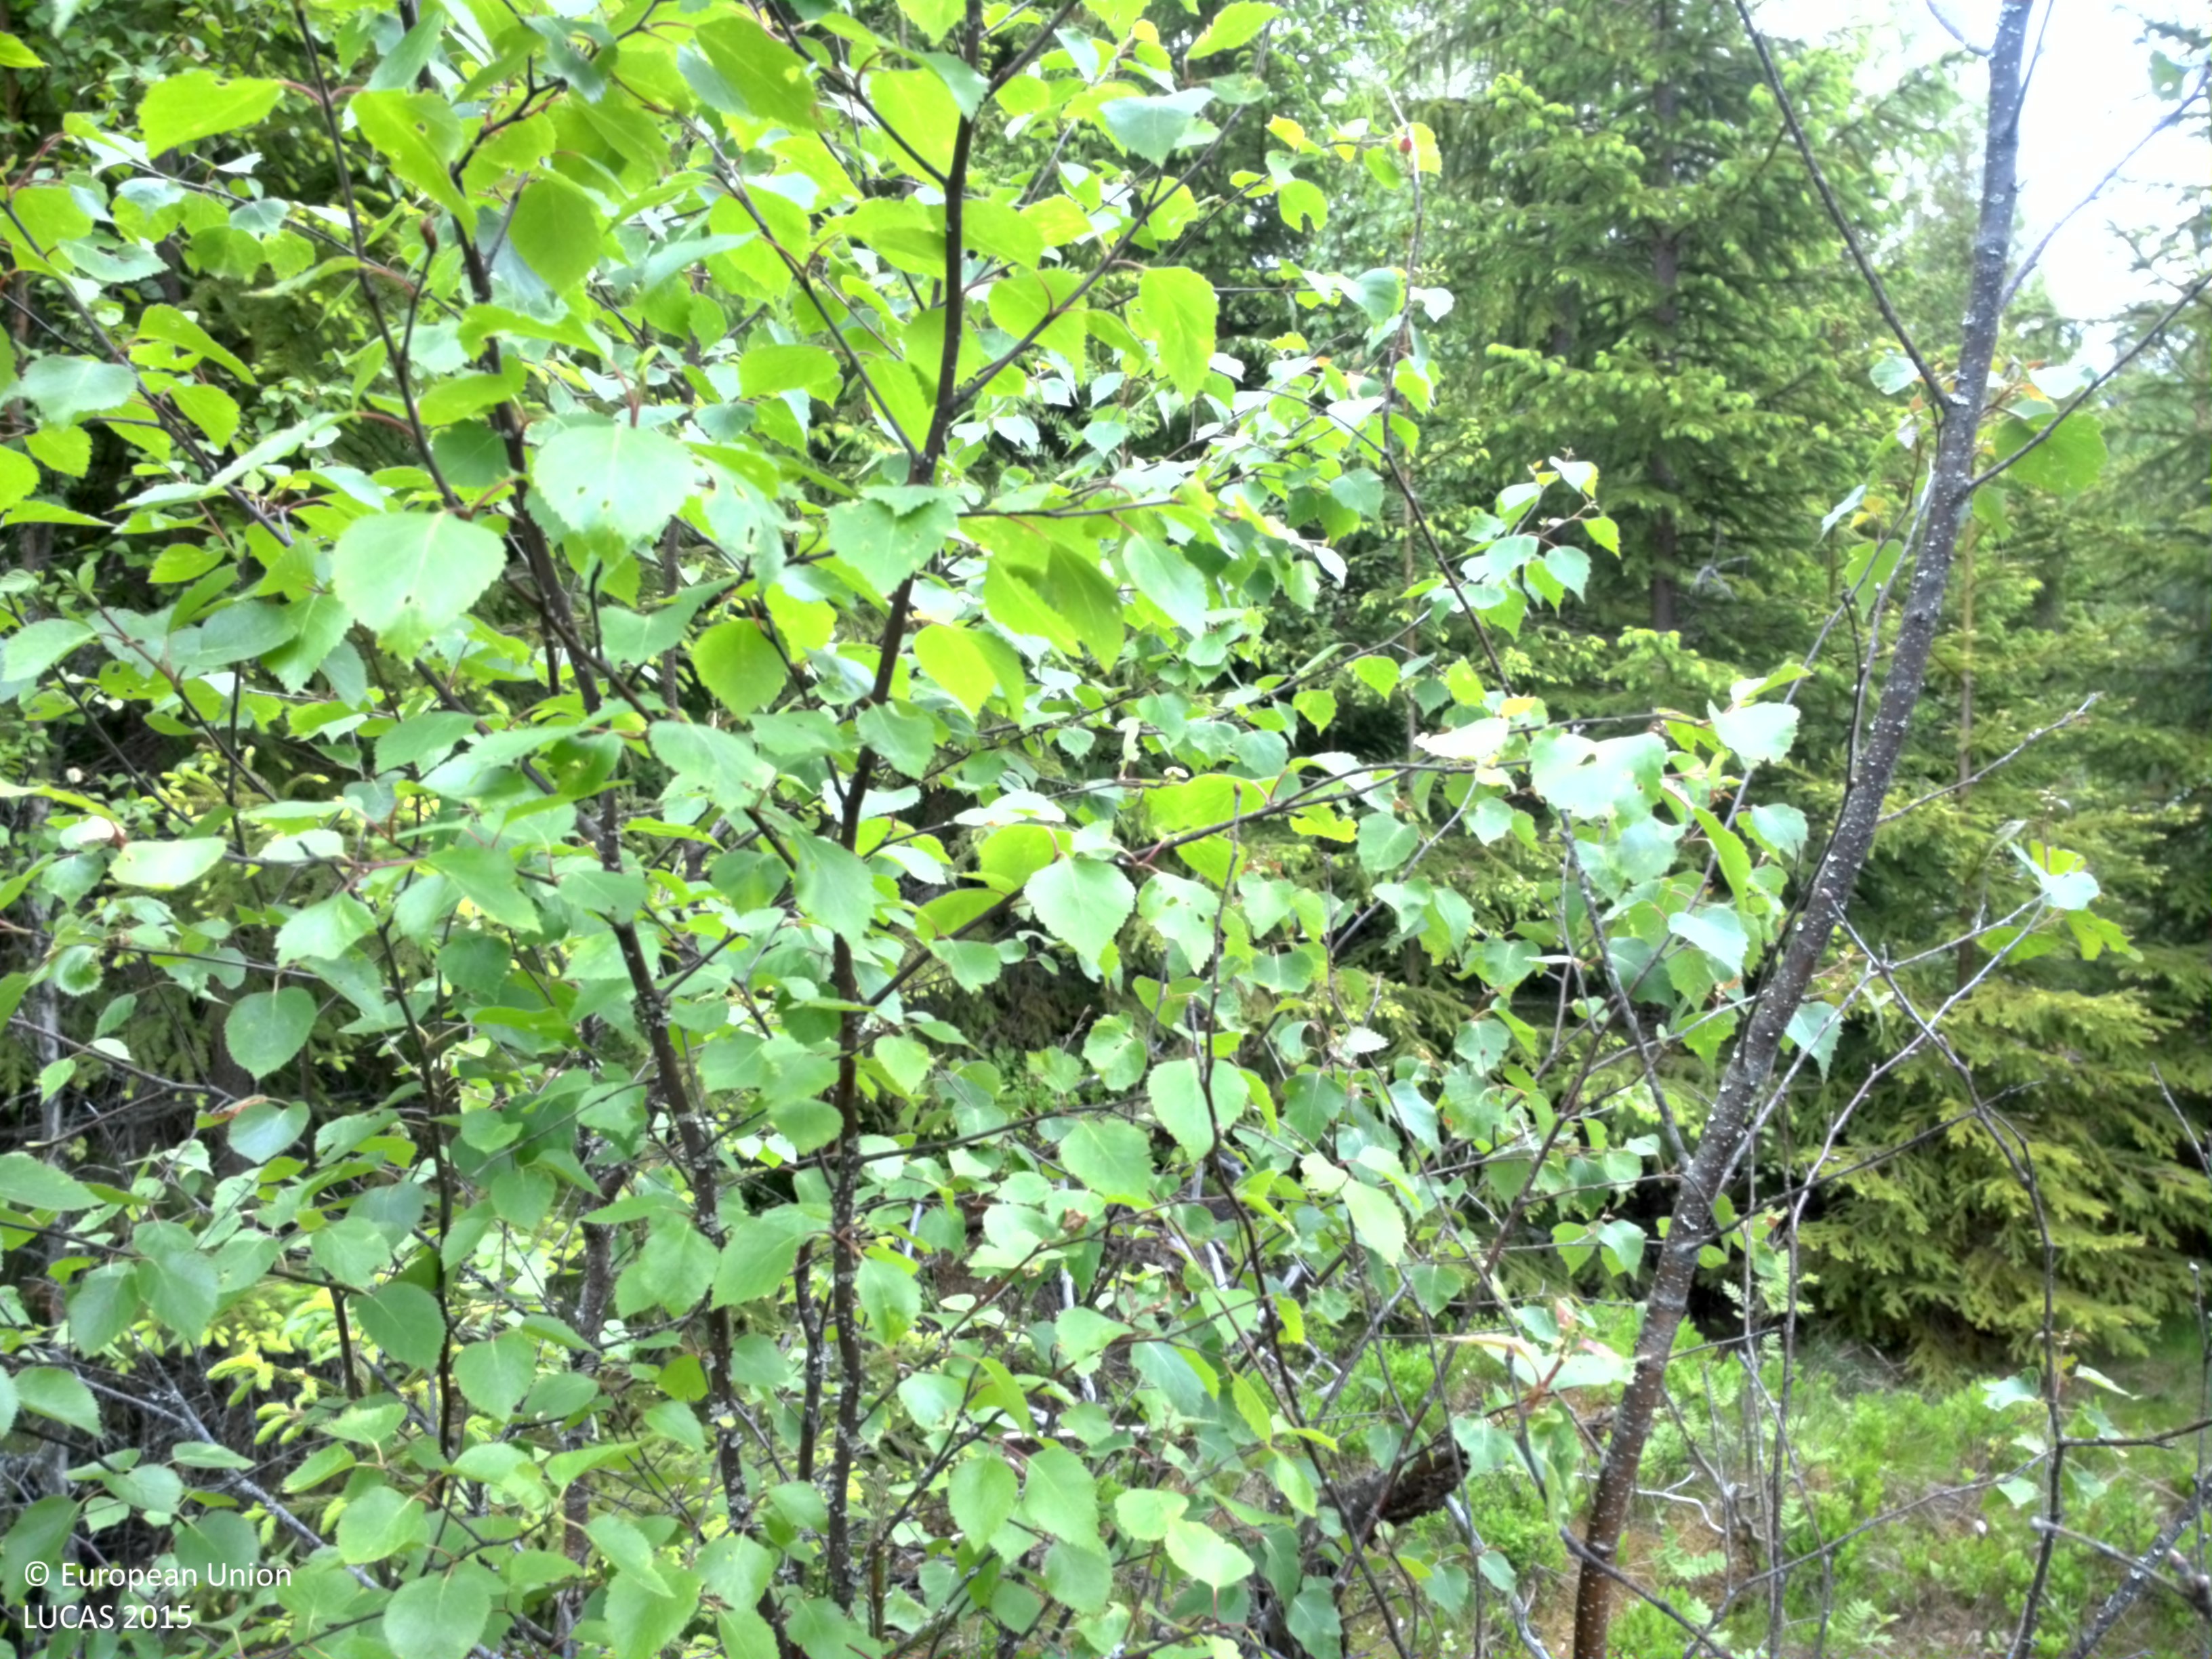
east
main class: Woodland
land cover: Spruce dominated mixed woodland
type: boreal forest
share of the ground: 50 - 75 %
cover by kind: coniferous forest trees 40 %, broadleaved forest trees 30 %, shrubs 15 %, herbaceous plants 10 %, lichens and mosses 5 %
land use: Forestry
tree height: < 5 m
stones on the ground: < 10 %
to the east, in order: Spruce dominated mixed woodland; Paved roads, cycling and walking lanes; Pine dominated coniferous woodland; Tracks; Pine dominated coniferous woodland; Tracks; Spruce dominated coniferous woodland; Rivers and streams; Spruce dominated coniferous woodland; Spruce dominated mixed woodland; Other mixed woodland
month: June
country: SE
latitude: 59.5892
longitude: 14.4008
